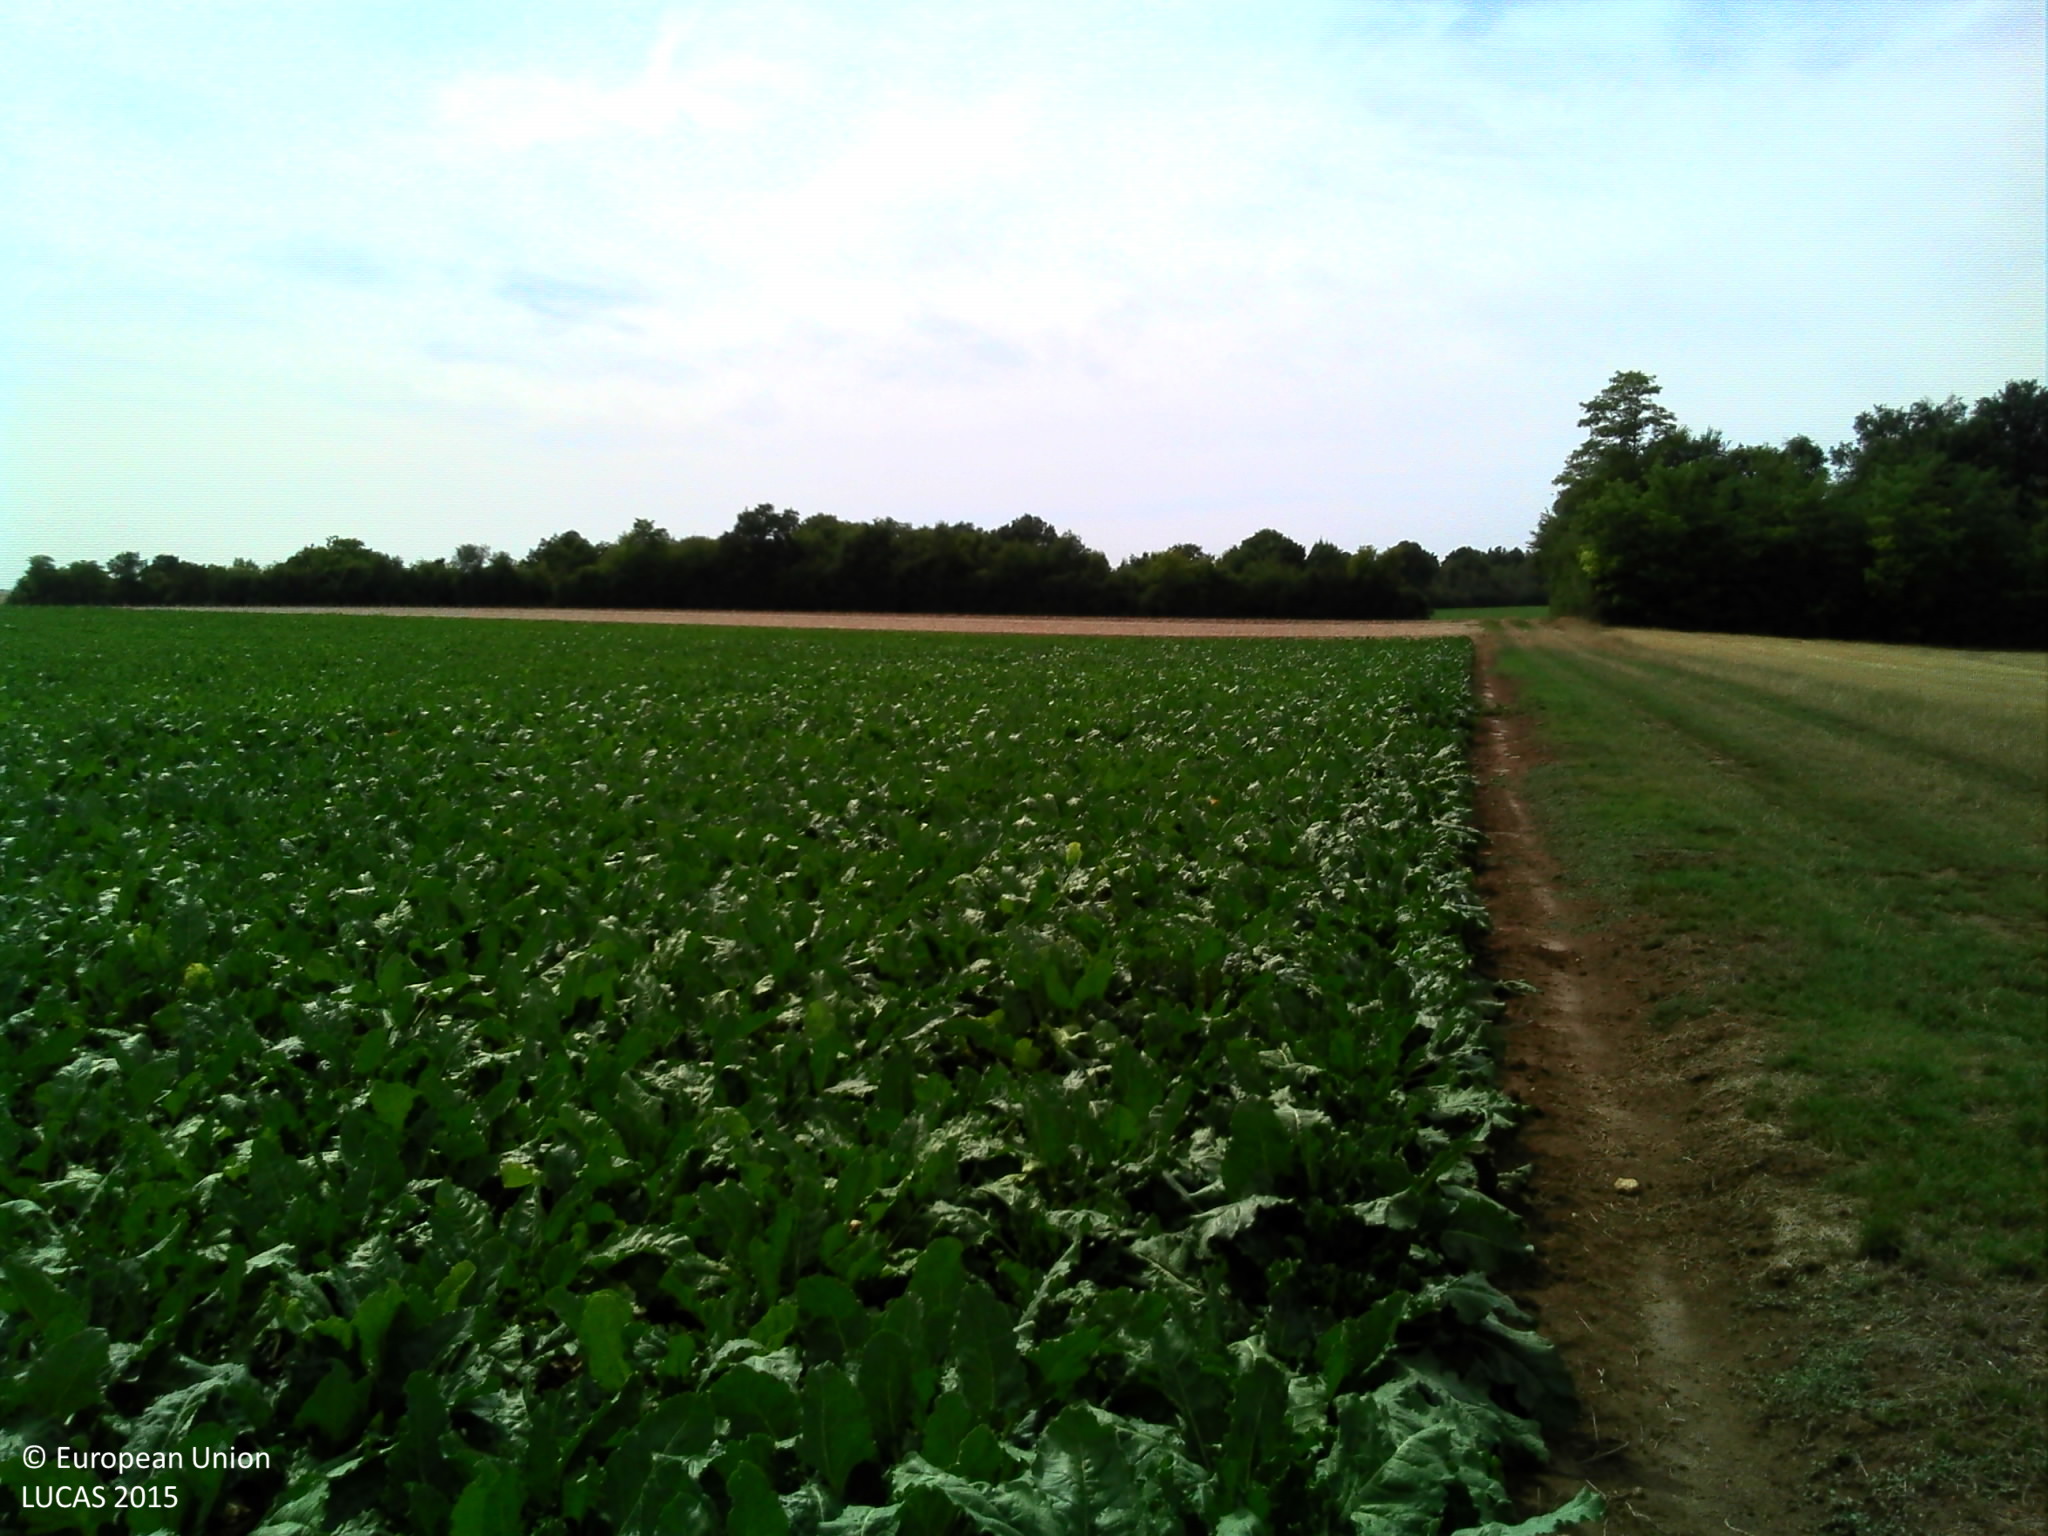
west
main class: Cropland
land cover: Sugar beet
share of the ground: > 75 %
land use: Agriculture (excluding fallow land and kitchen gardens)
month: August
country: FR
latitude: 48.2383
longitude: 2.4901
